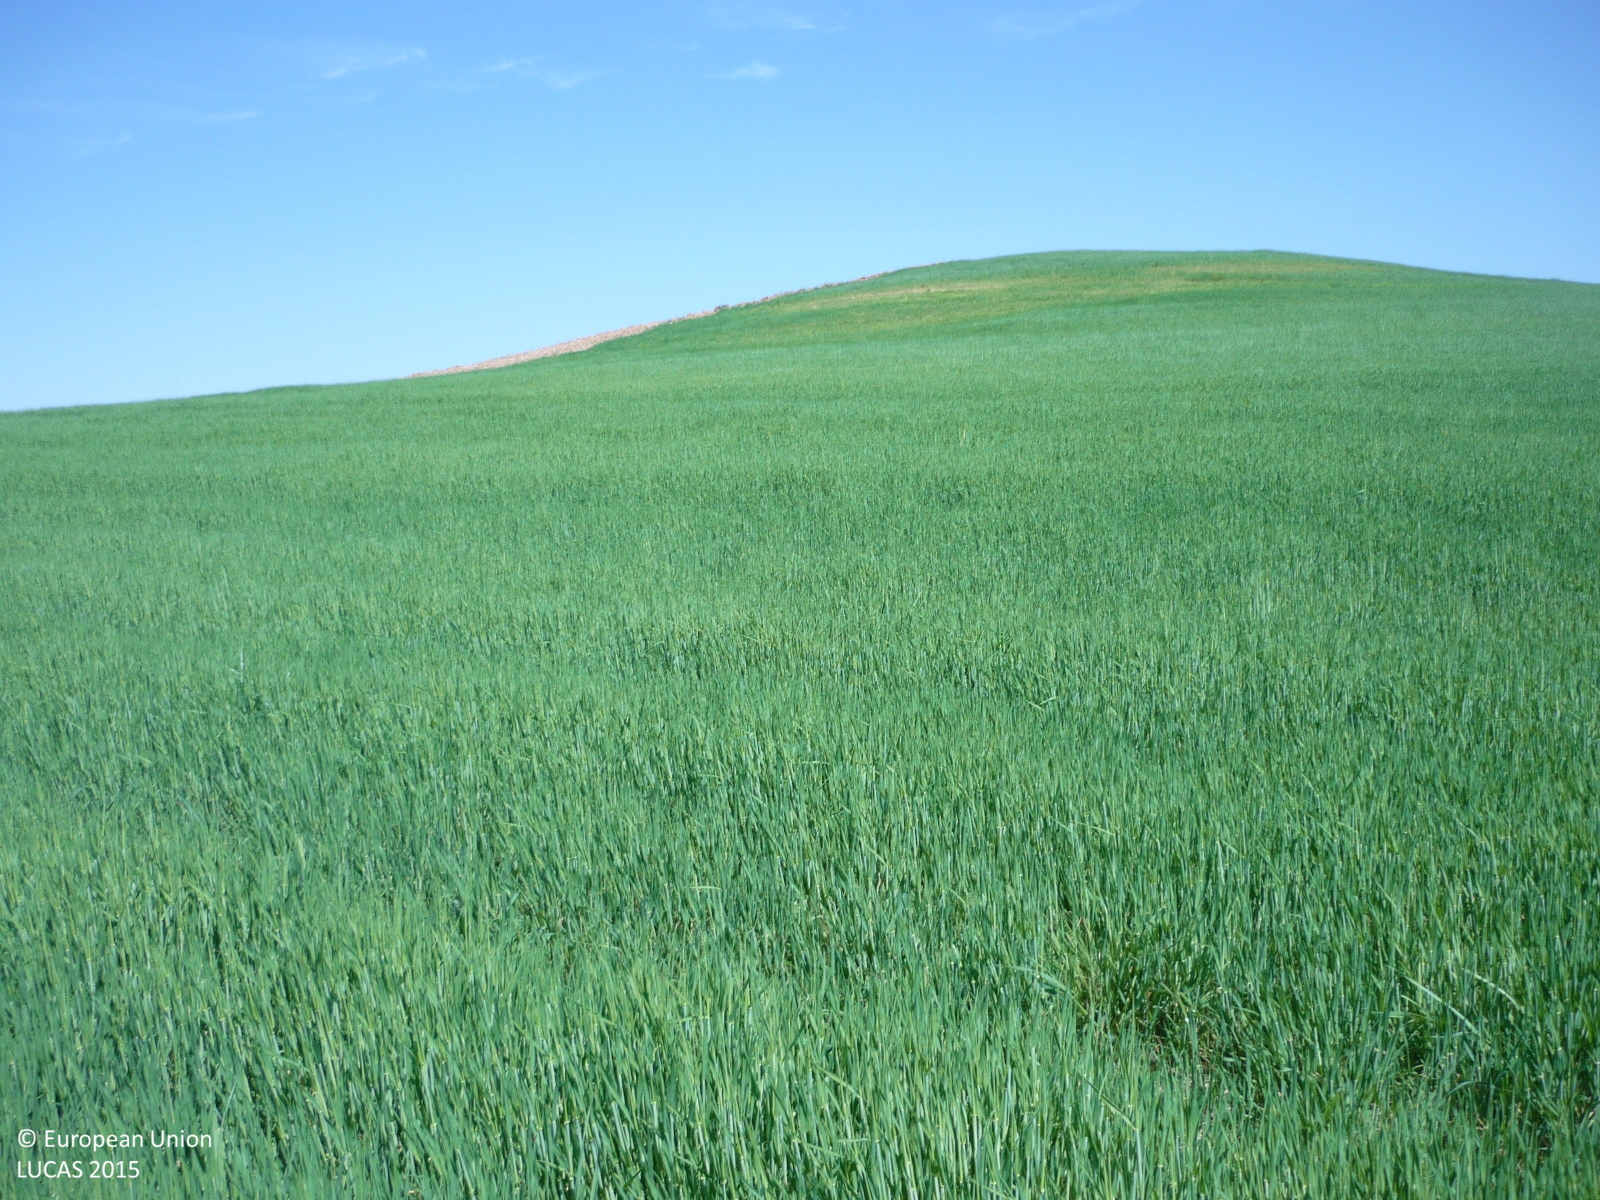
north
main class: Cropland
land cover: Barley
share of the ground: > 75 %
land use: Agriculture (excluding fallow land and kitchen gardens)
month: April
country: ES
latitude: 40.6128
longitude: -3.3562
